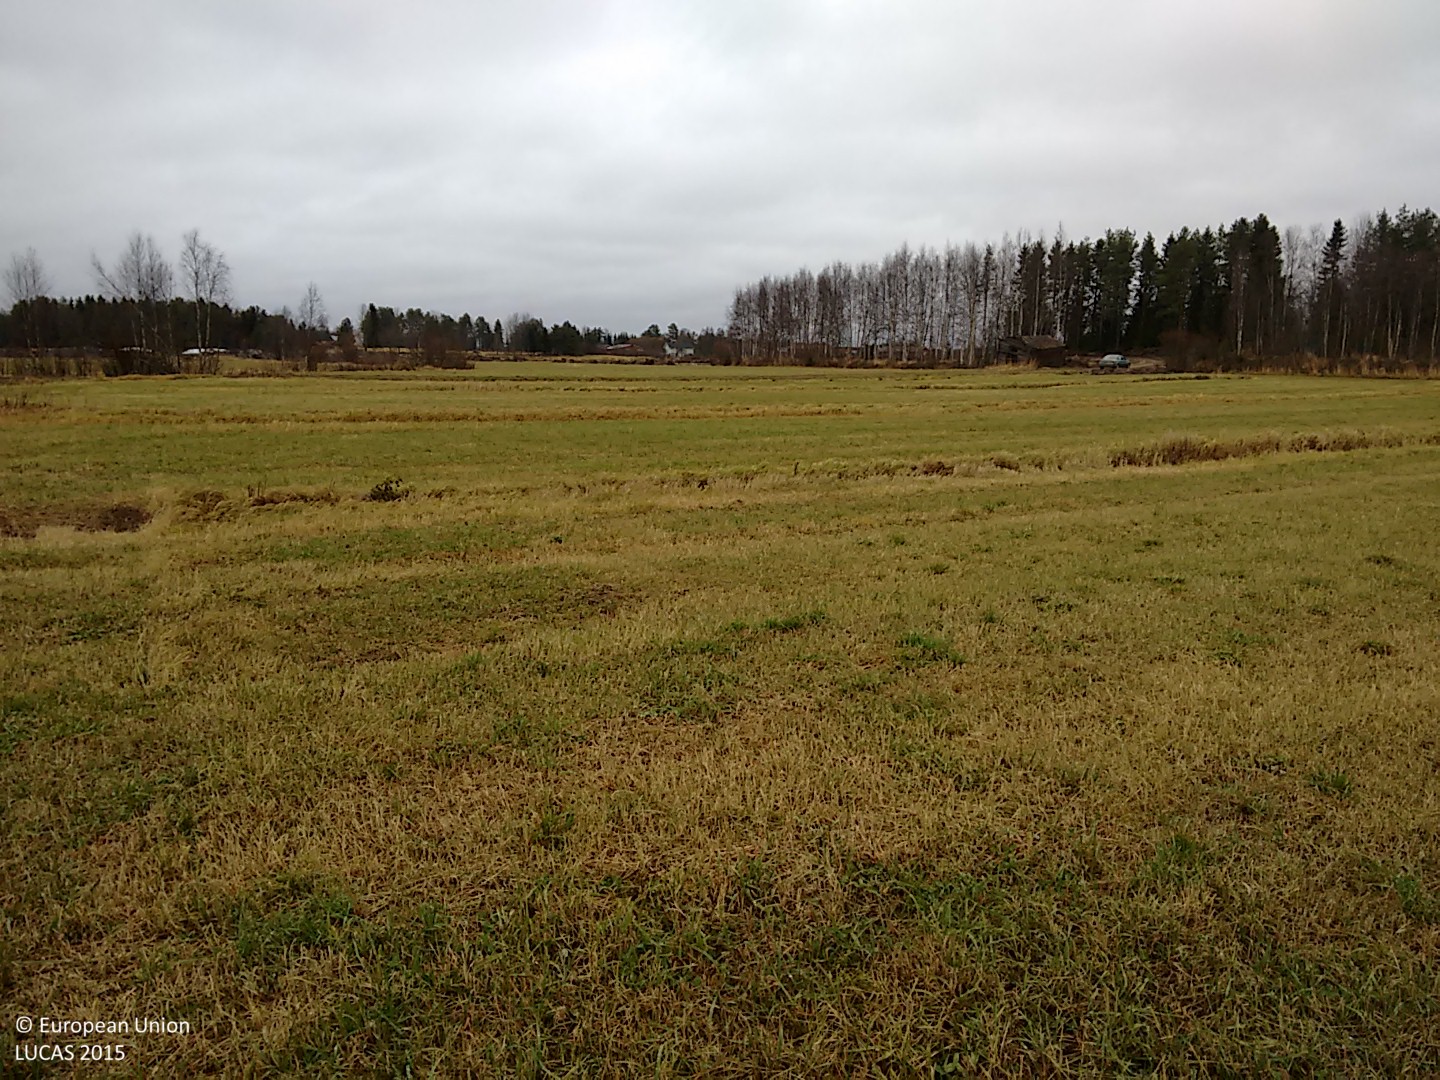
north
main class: Grassland
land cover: Grassland without tree/shrub cover
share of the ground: > 75 %
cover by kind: herbaceous plants 100 %
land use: Agriculture (excluding fallow land and kitchen gardens)
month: October
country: FI
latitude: 64.5384
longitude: 25.2827
